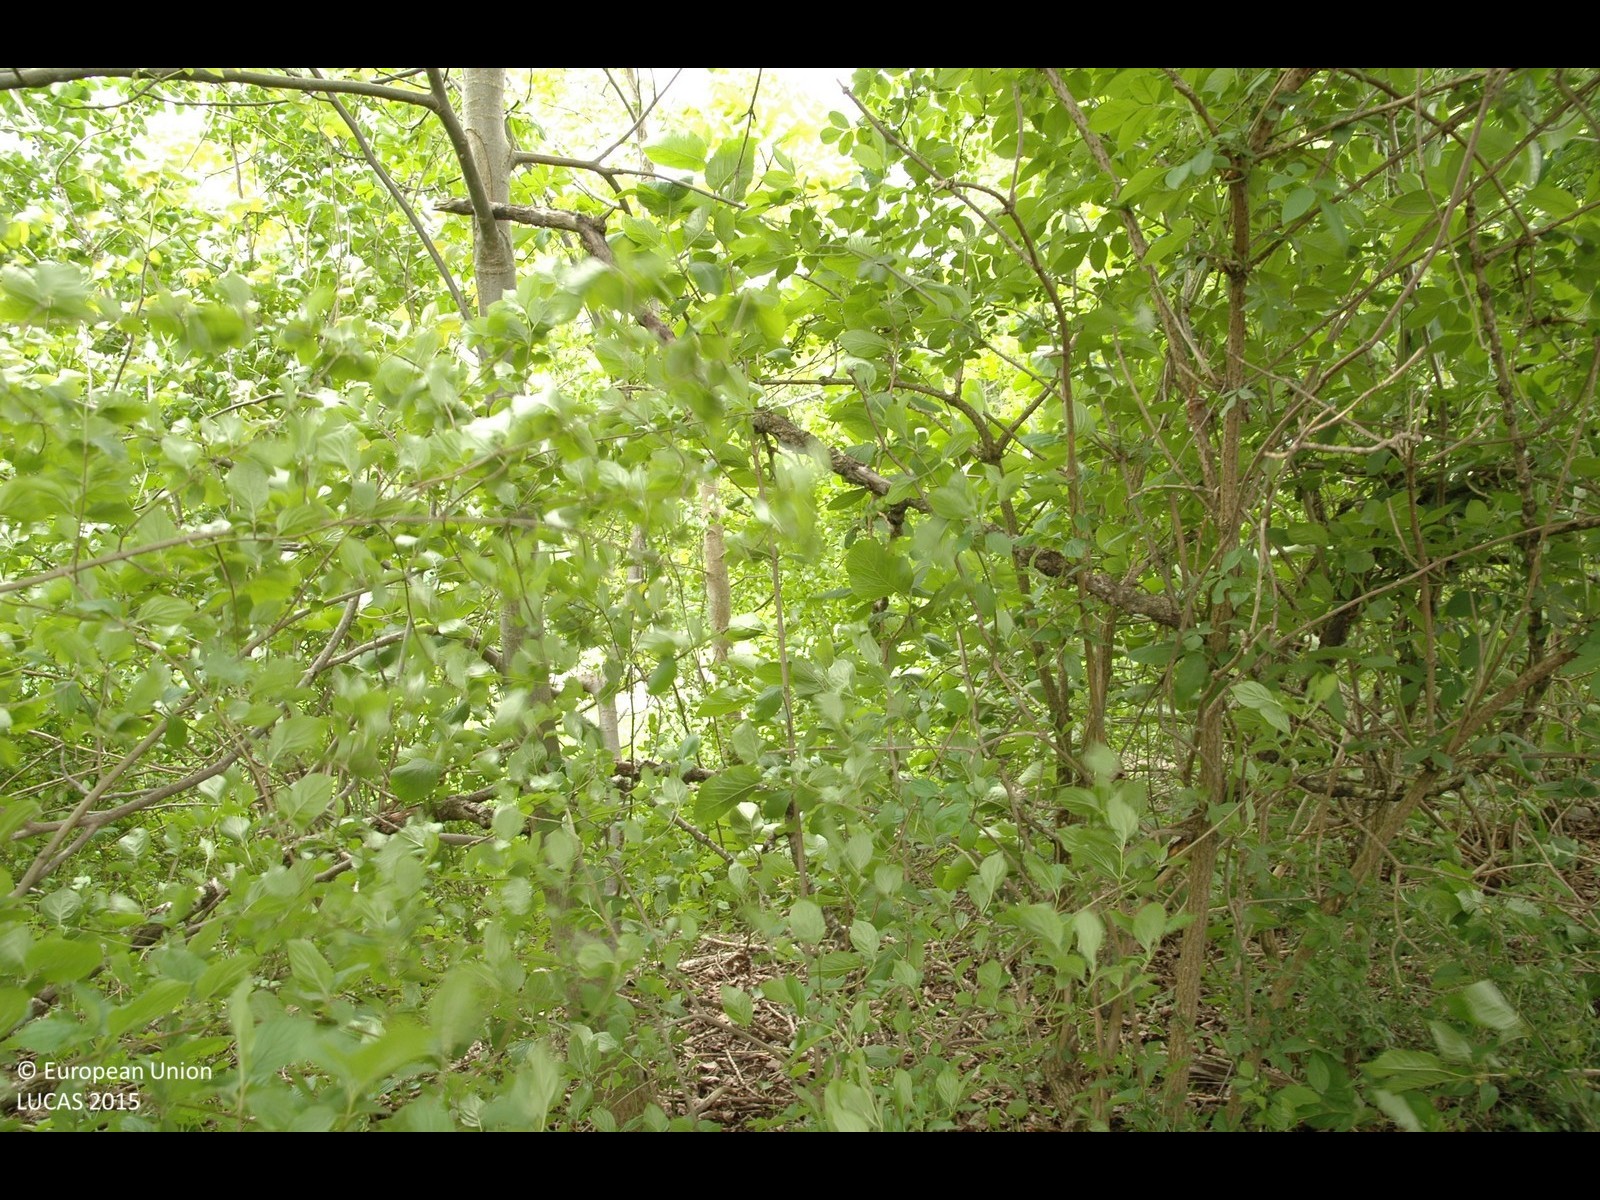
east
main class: Woodland
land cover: Broadleaved woodland
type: floodplain forest
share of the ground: > 75 %
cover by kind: broadleaved forest trees 80 %, shrubs 10 %, herbaceous plants 10 %
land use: Forestry
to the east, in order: Broadleaved woodland; Spontaneously vegetated surfaces; Abandoned hedges; Grassland without tree/shrub cover; Tracks; Other structural elements
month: May
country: HR
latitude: 45.8353
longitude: 15.7523
